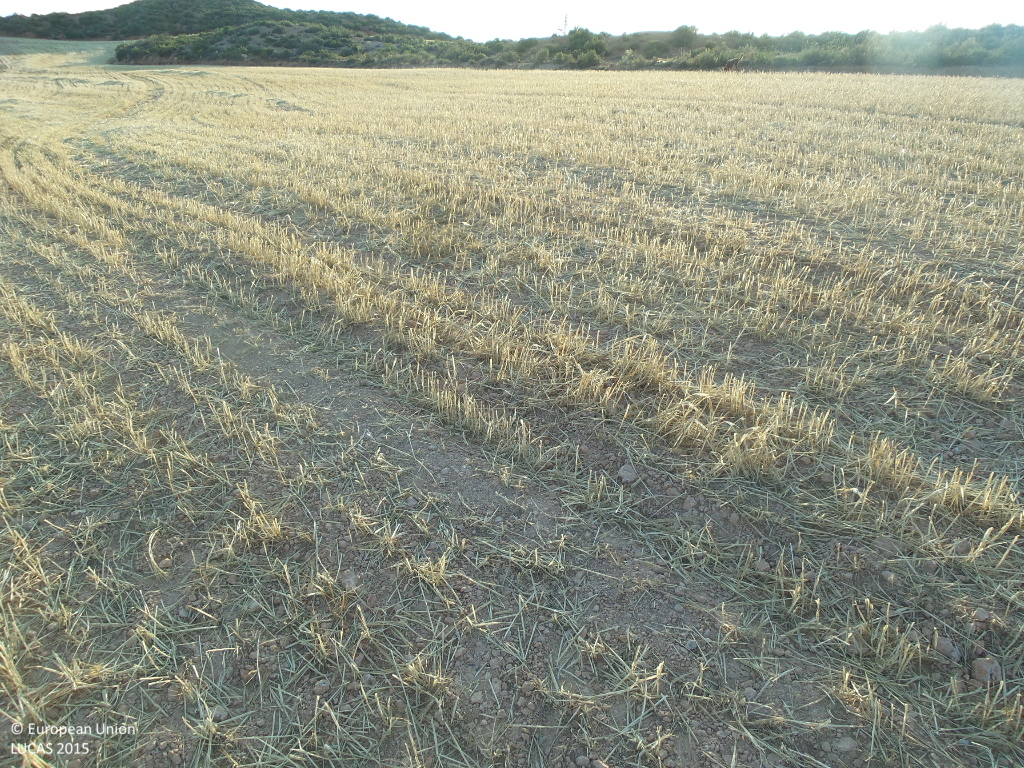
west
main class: Cropland
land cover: Barley
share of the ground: < 10 %
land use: Agriculture (excluding fallow land and kitchen gardens)
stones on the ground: < 10 %
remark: Harvested field
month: July
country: ES
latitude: 41.2812
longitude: -2.1479
